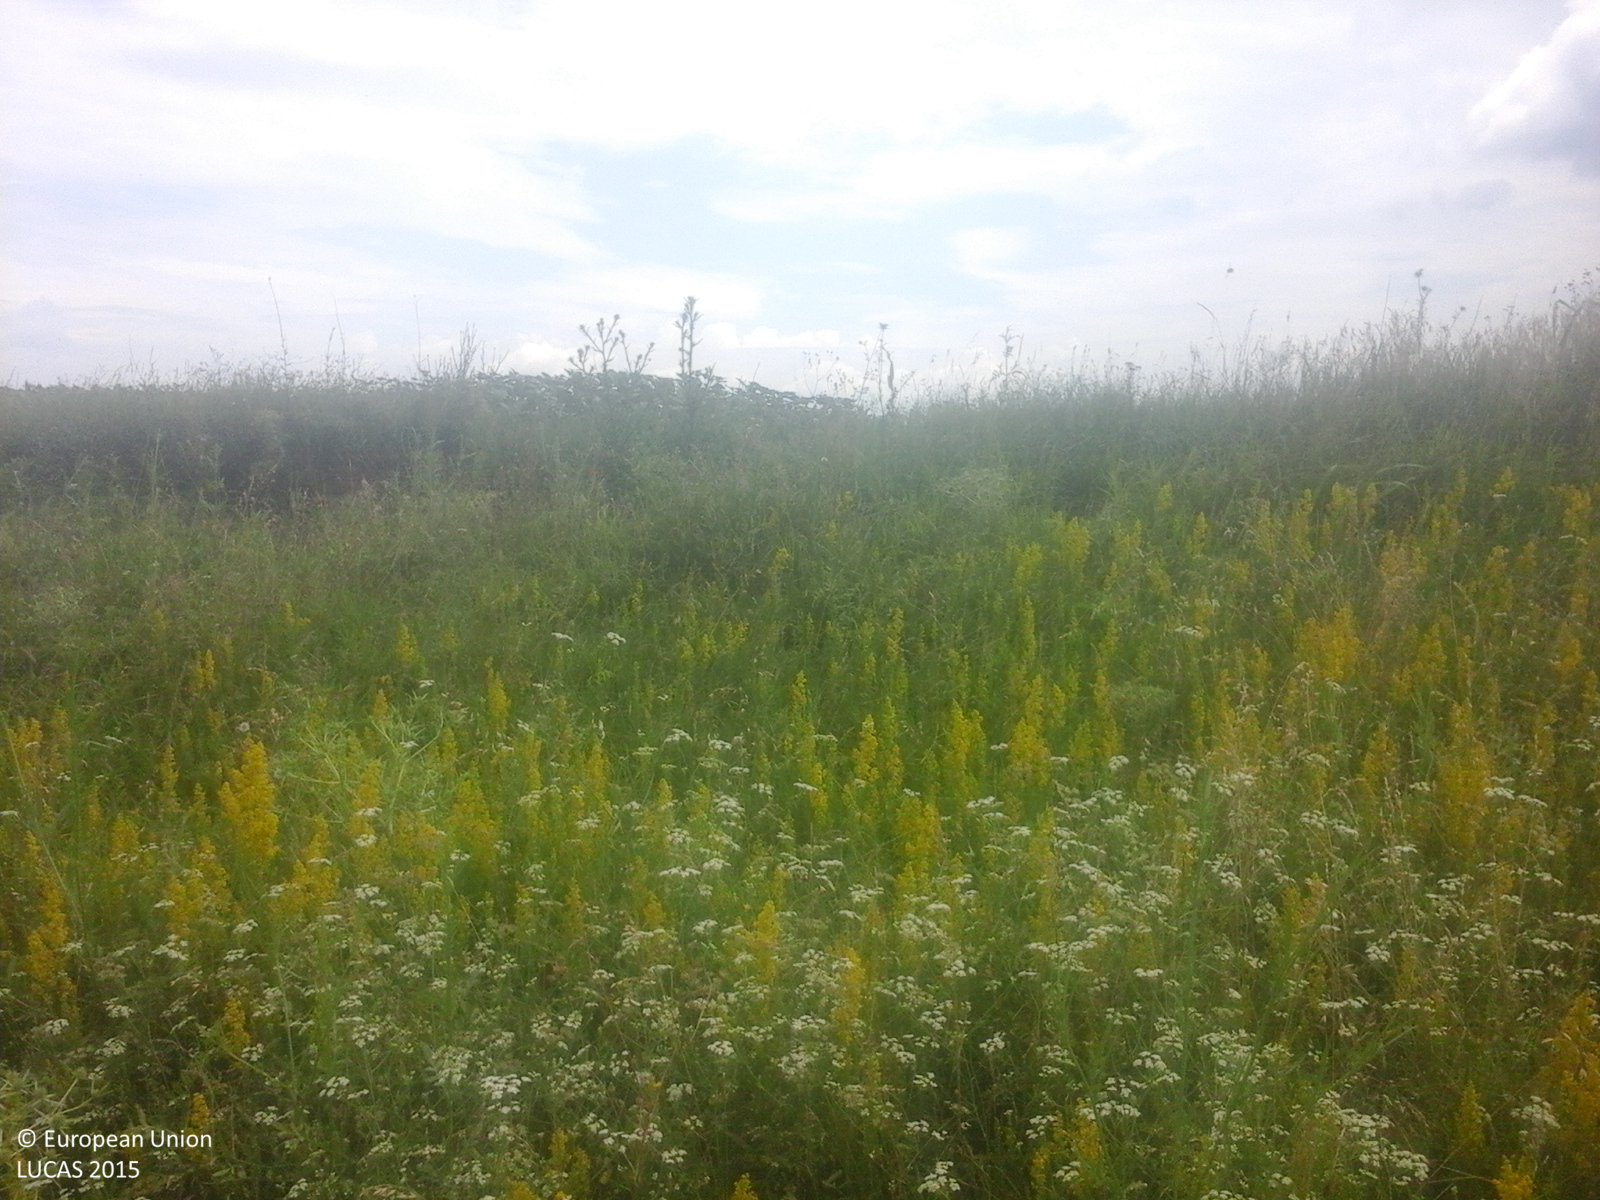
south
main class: Grassland
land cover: Spontaneously vegetated surfaces
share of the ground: > 75 %
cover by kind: herbaceous plants 100 %
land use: Fallow land
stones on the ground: < 10 %
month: July
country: RO
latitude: 43.7884
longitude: 24.7198
